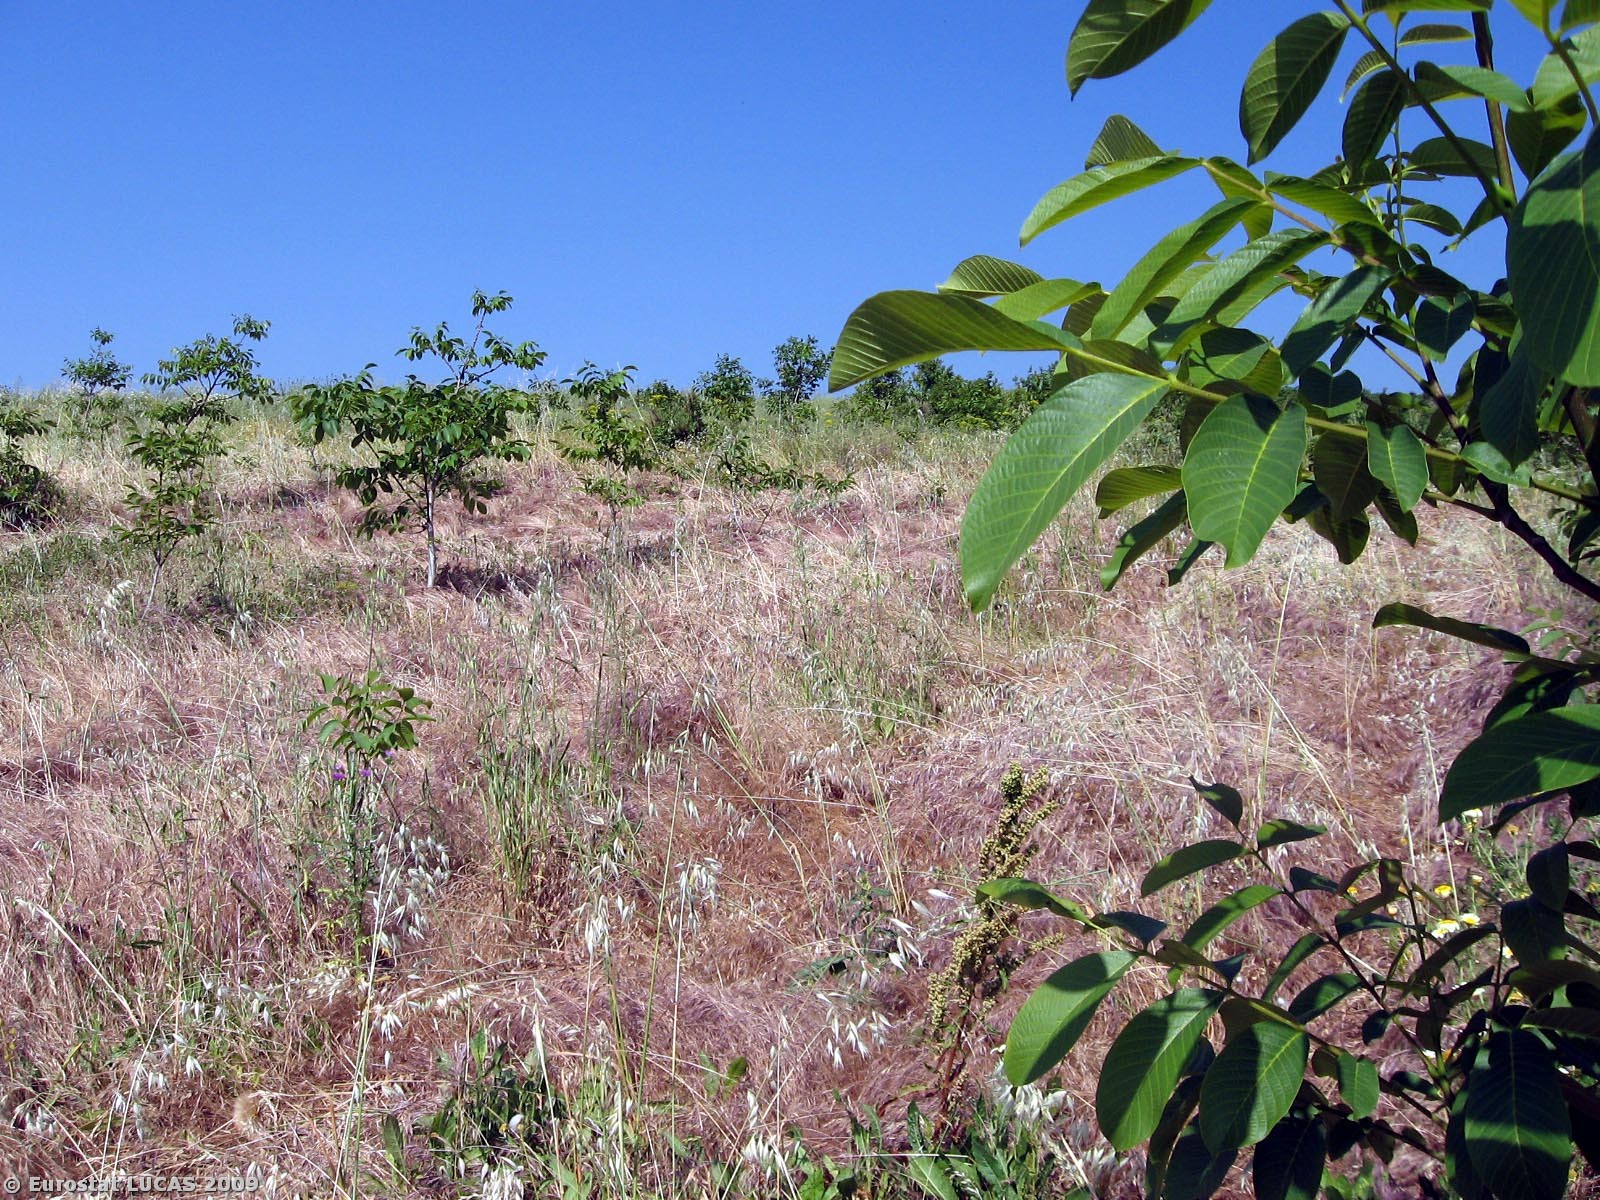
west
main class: Cropland
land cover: Nuts trees
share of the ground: 10 - 25 %
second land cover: Spontaneously vegetated surfaces
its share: > 75 %
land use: Agriculture (excluding fallow land and kitchen gardens)
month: May
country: IT
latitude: 38.9767
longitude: 16.8110
